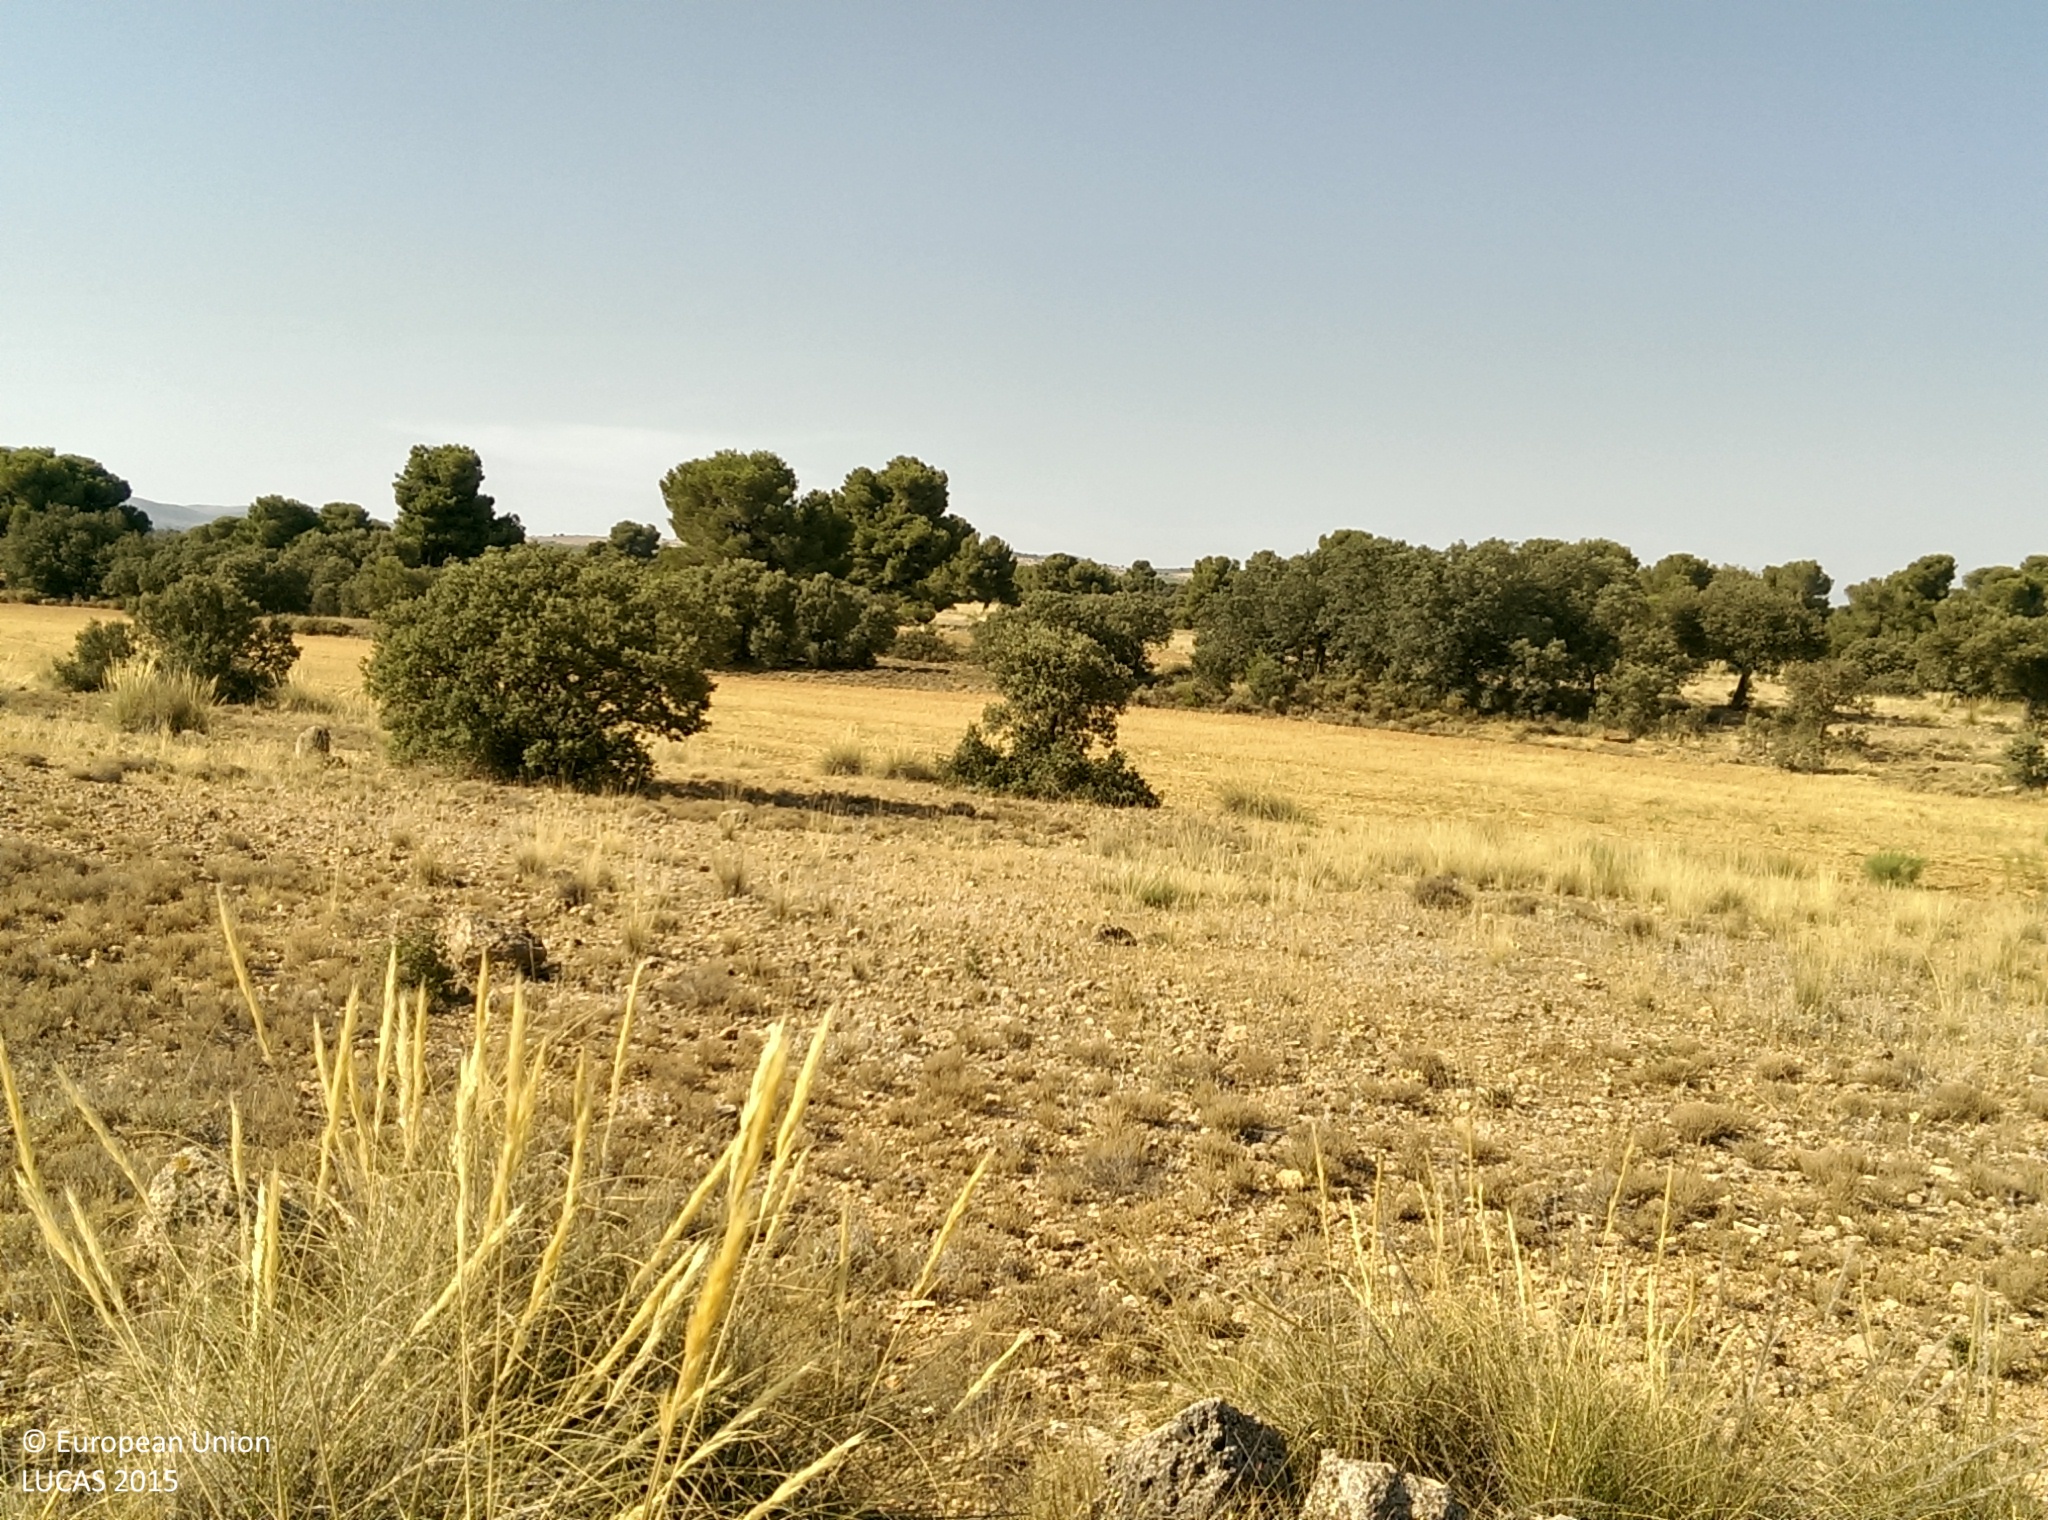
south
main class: Grassland
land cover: Grassland with sparse tree/shrub cover
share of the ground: > 75 %
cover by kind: herbaceous plants 80 %, consolidated bare surface 10 %, broadleaved forest trees 5 %, shrubs 5 %
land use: Semi-natural and natural areas not in use
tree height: < 5 m
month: July
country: ES
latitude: 37.4625
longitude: -2.9559
